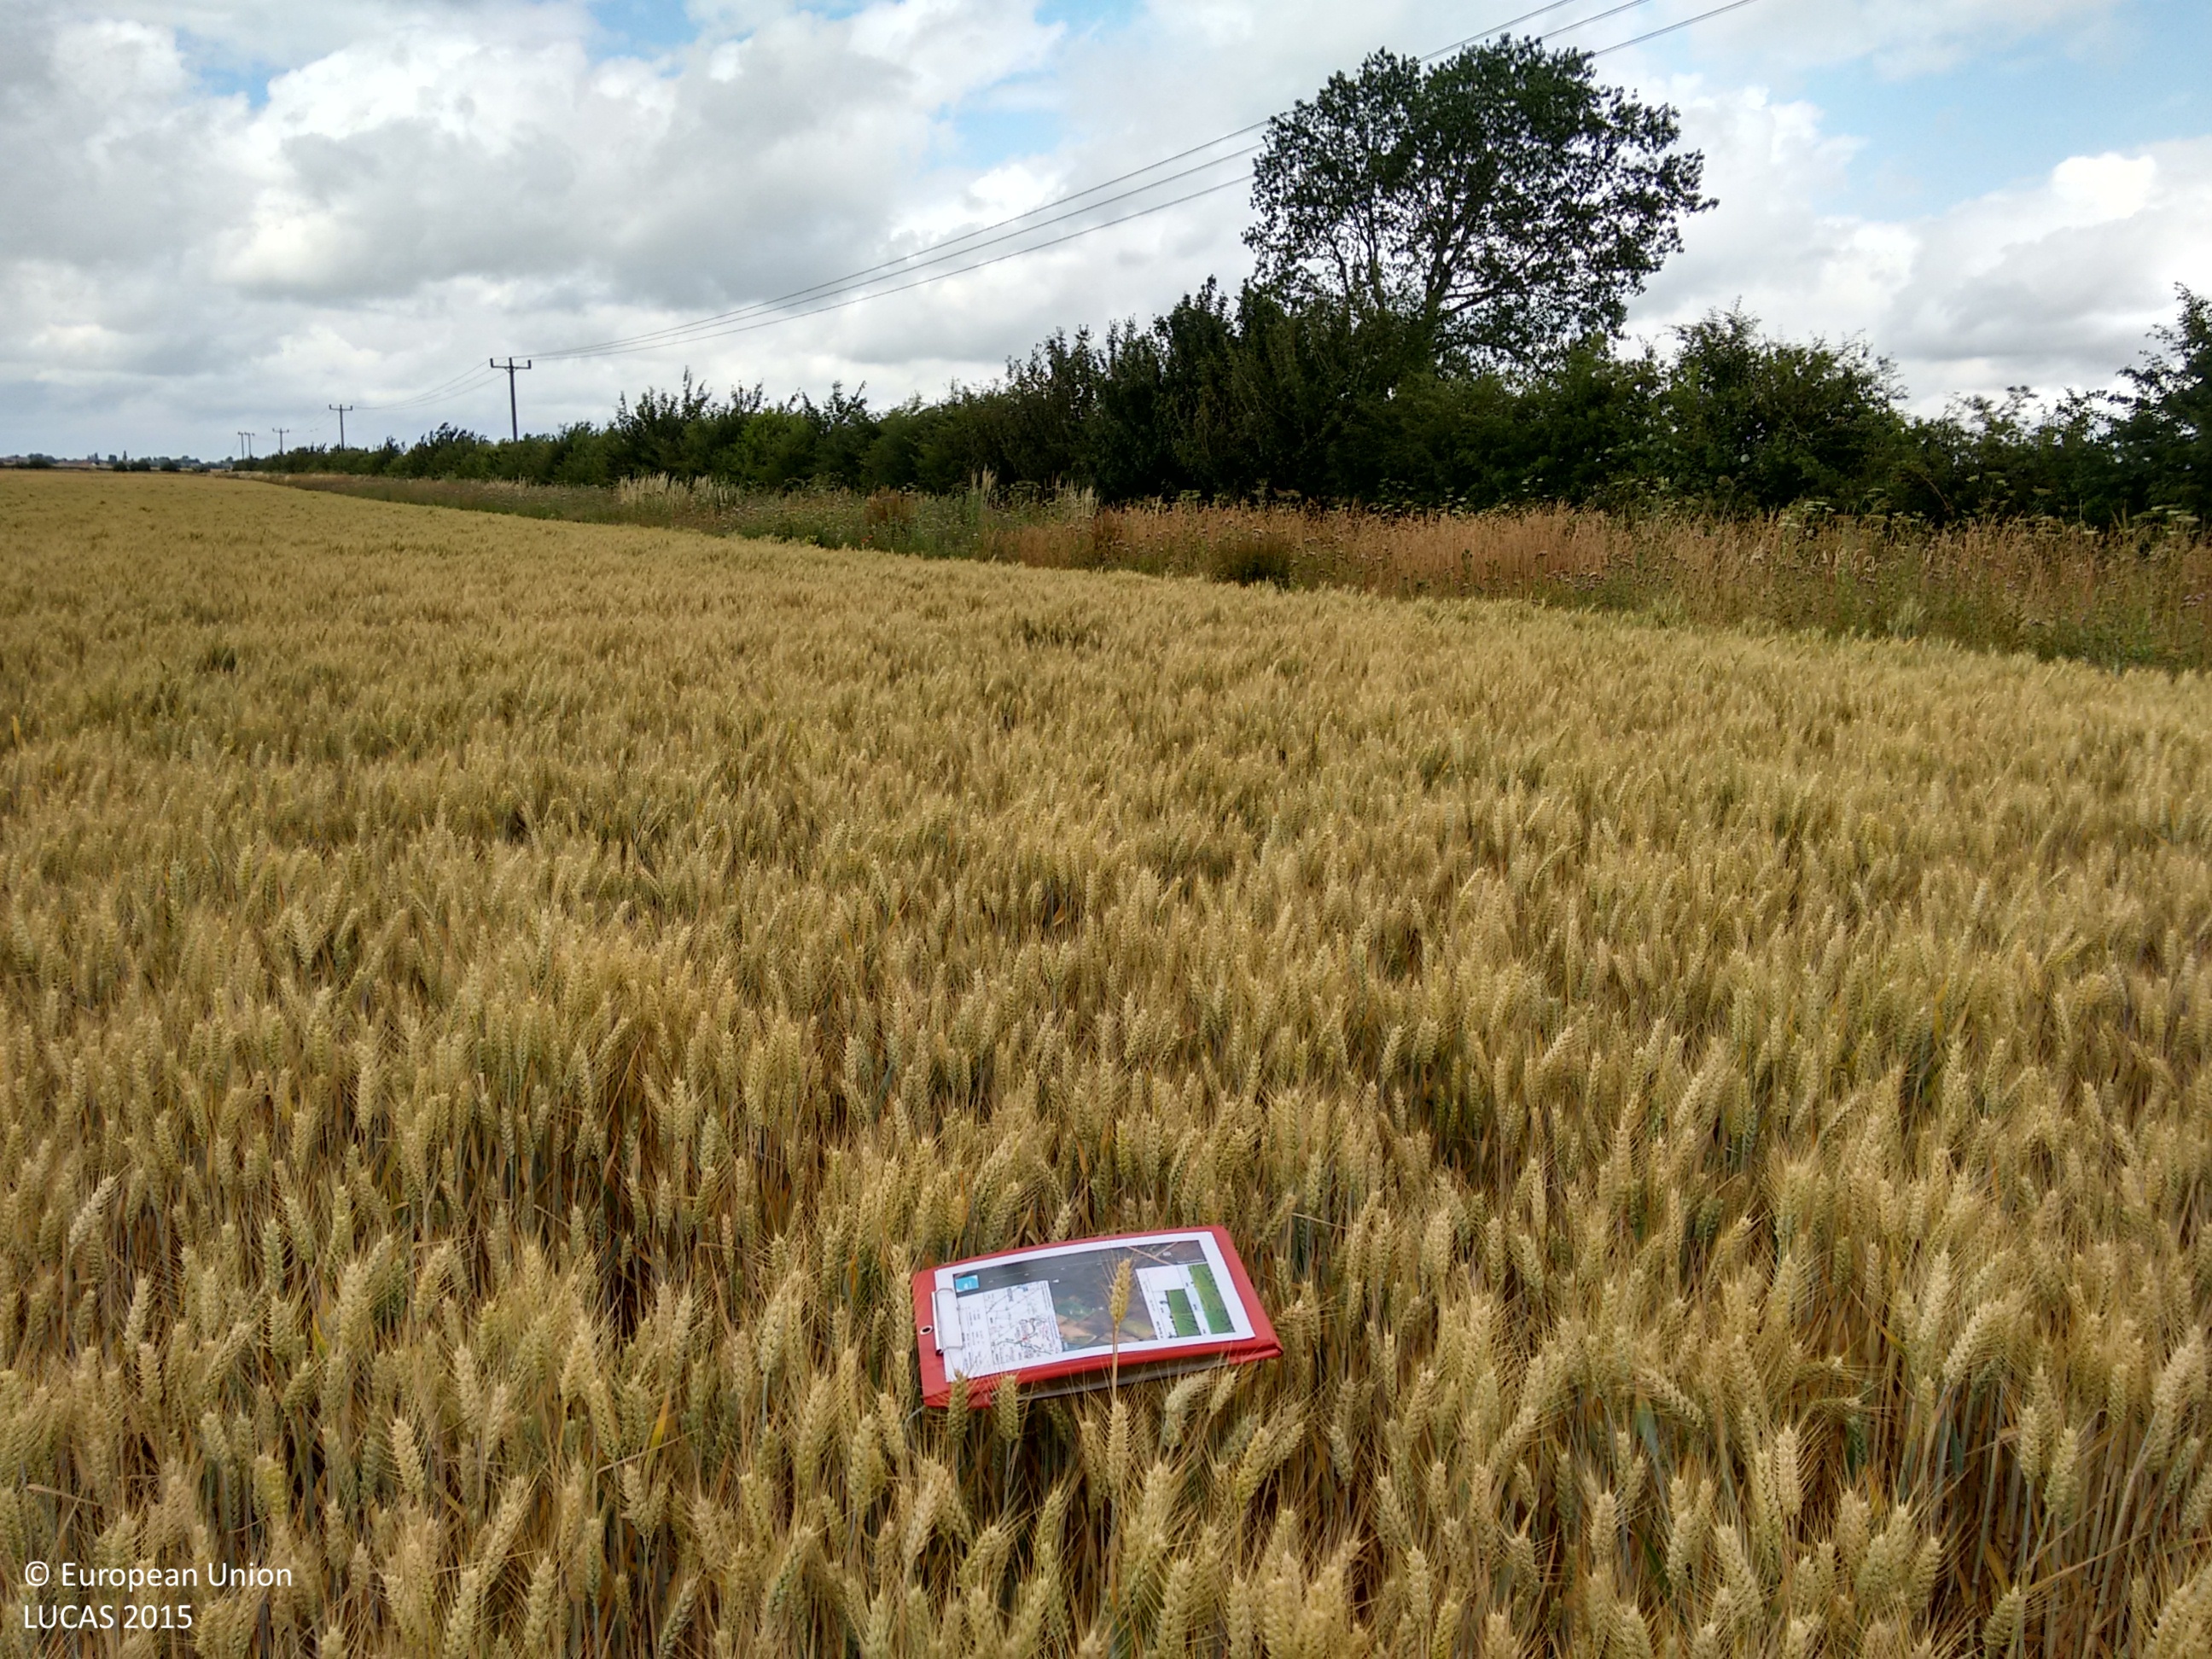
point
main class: Cropland
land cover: Common wheat
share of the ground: > 75 %
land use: Agriculture (excluding fallow land and kitchen gardens)
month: July
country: GB
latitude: 52.4312
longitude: 0.0698
